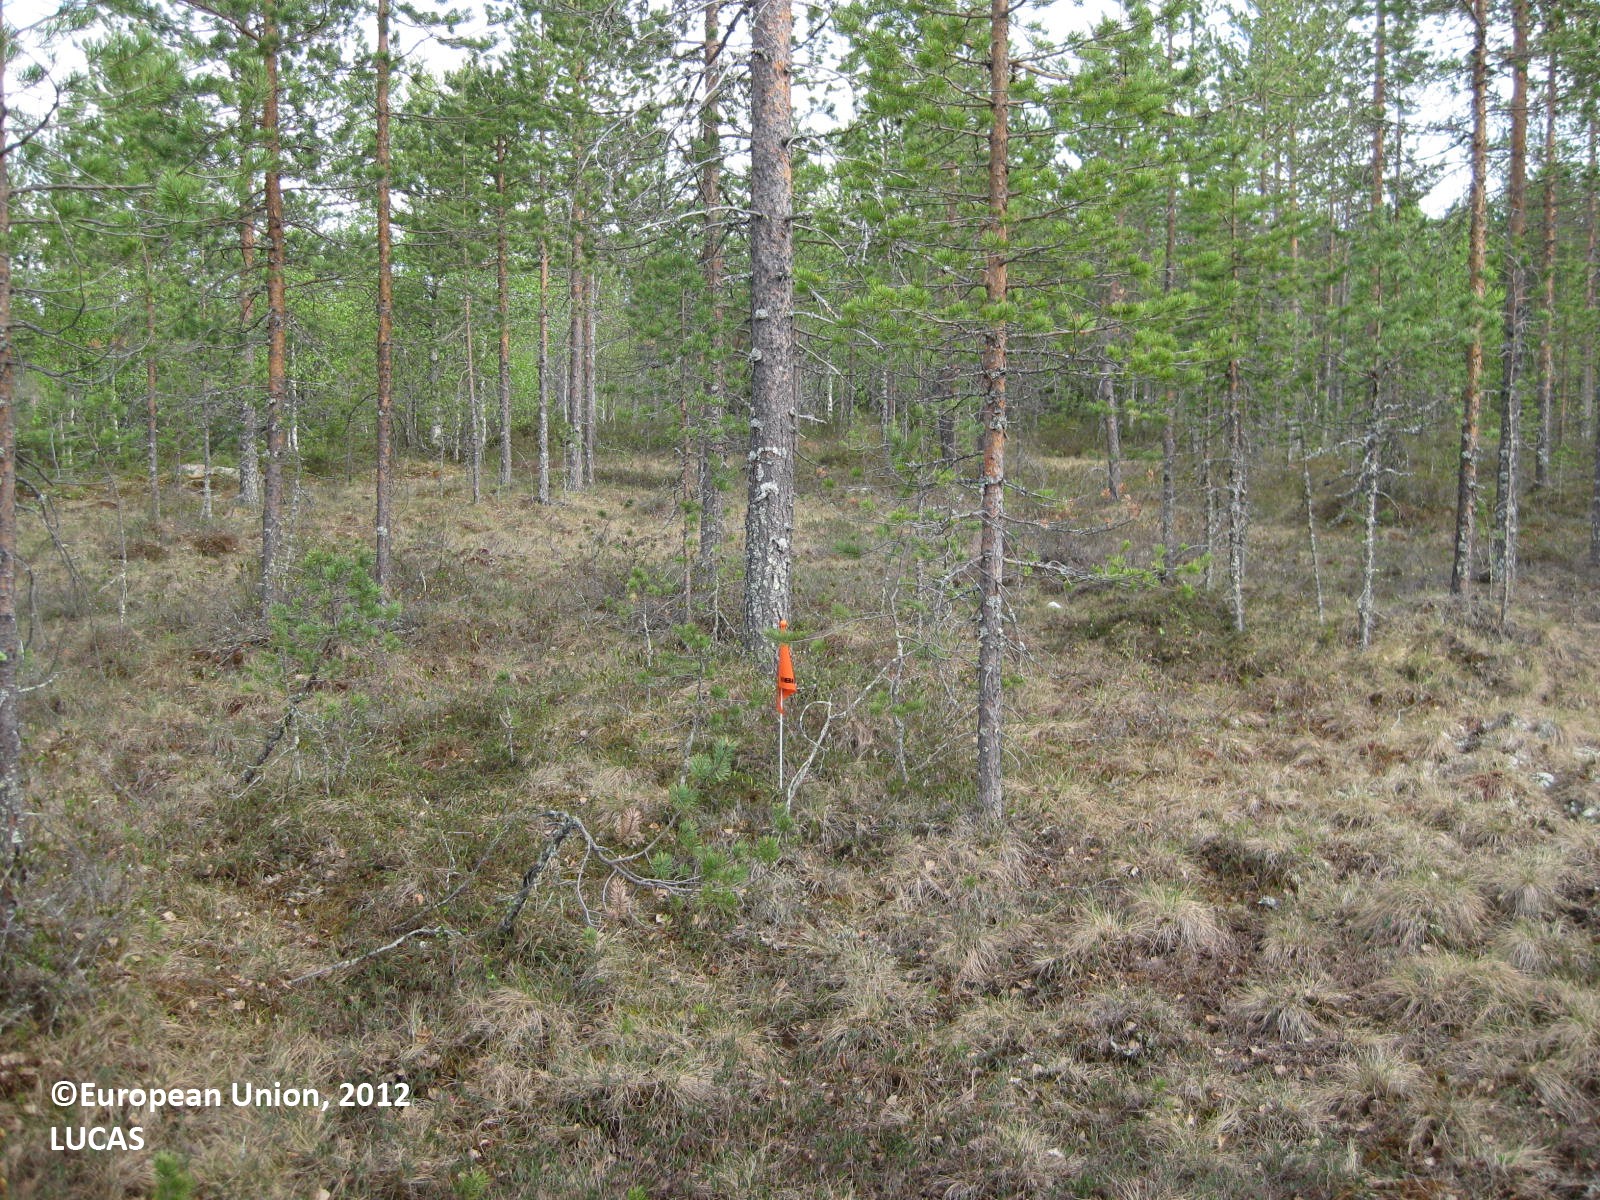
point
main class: Woodland
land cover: Pine dominated coniferous woodland
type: boreal forest
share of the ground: 50 - 75 %
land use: Forestry
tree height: > 5 m
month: June
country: FI
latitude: 65.1379
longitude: 29.4952
